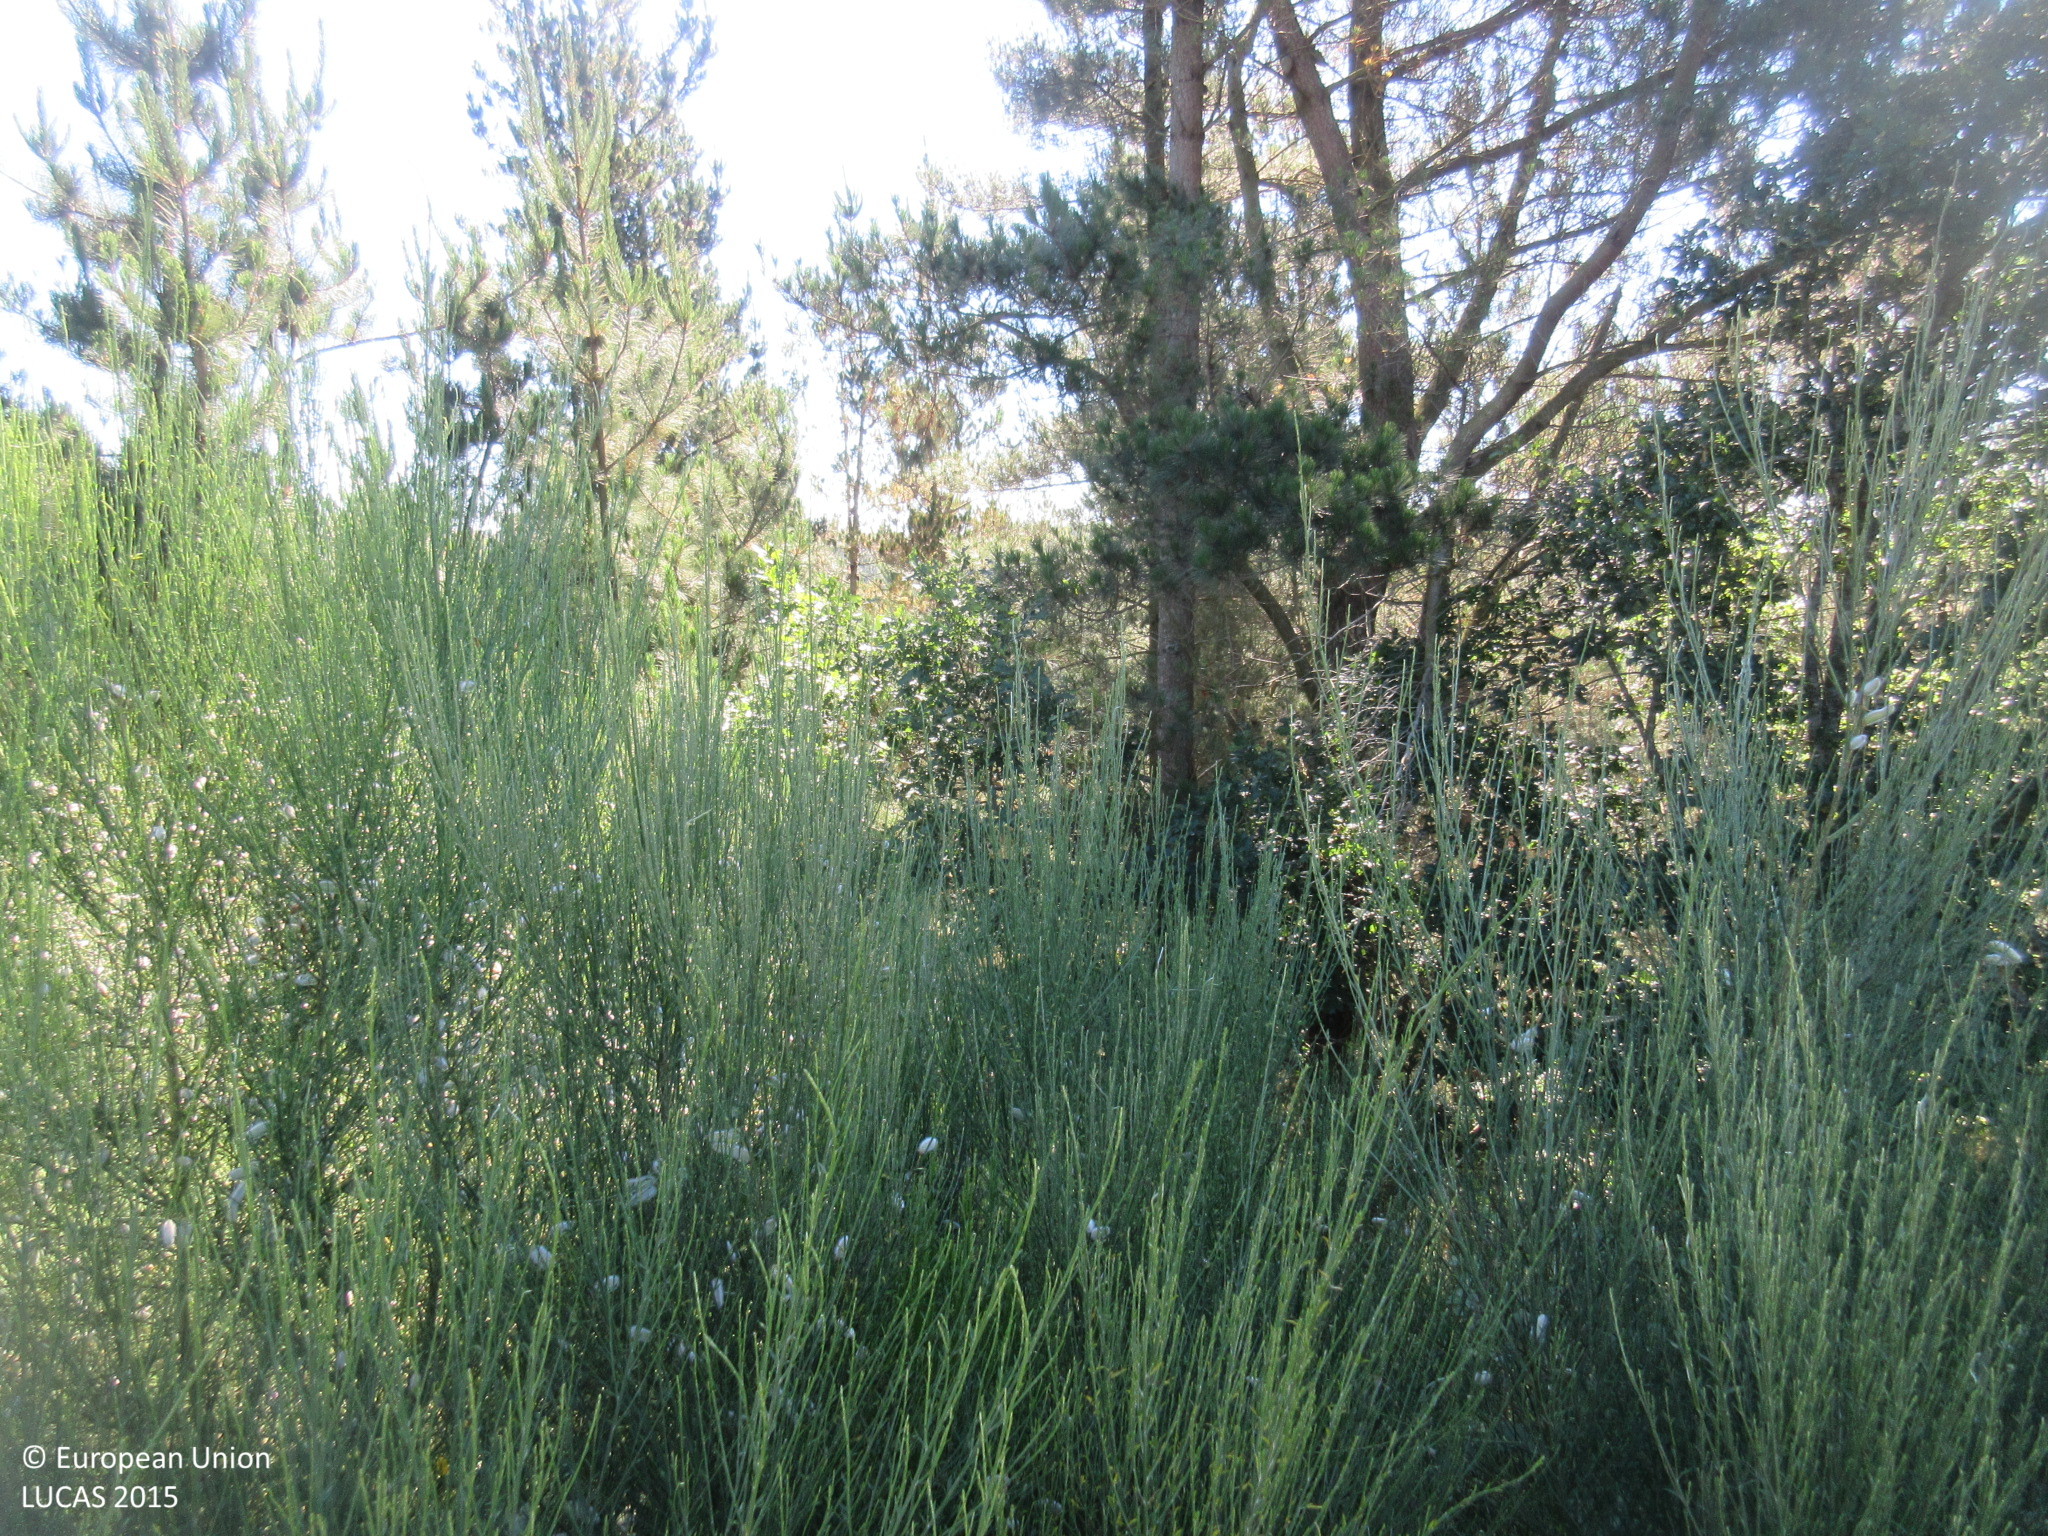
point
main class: Woodland
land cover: Pine dominated coniferous woodland
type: hemiboreal forest and nemoral coniferous forest and mixed broadleaved-coniferous forest
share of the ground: > 75 %
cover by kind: coniferous forest trees 90 %, broadleaved forest trees 10 %
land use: Forestry
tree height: > 5 m
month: June
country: ES
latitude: 43.2452
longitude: -7.1257
